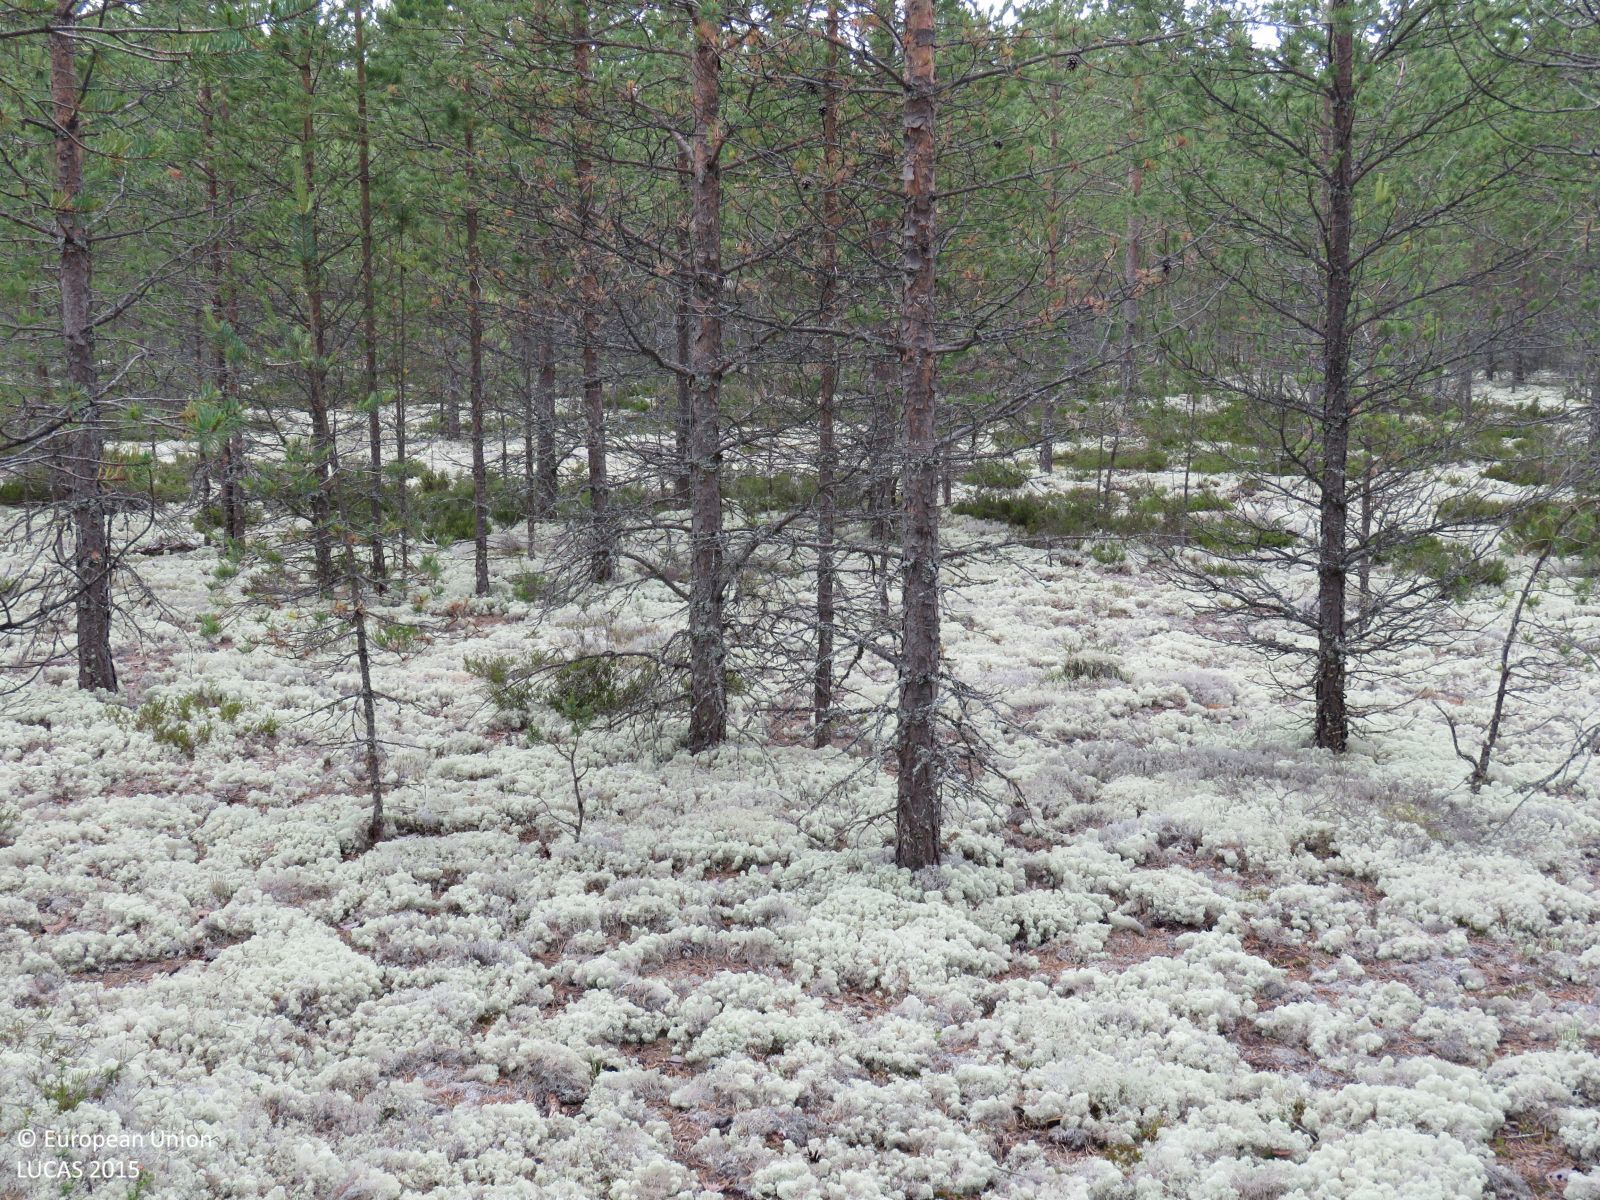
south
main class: Woodland
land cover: Pine dominated coniferous woodland
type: boreal forest
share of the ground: 50 - 75 %
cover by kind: coniferous forest trees 50 %, lichens and mosses 35 %, shrubs 10 %, unconsolidated bare surface 5 %
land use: Forestry
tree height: > 5 m
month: July
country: FI
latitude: 64.4822
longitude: 26.7446
